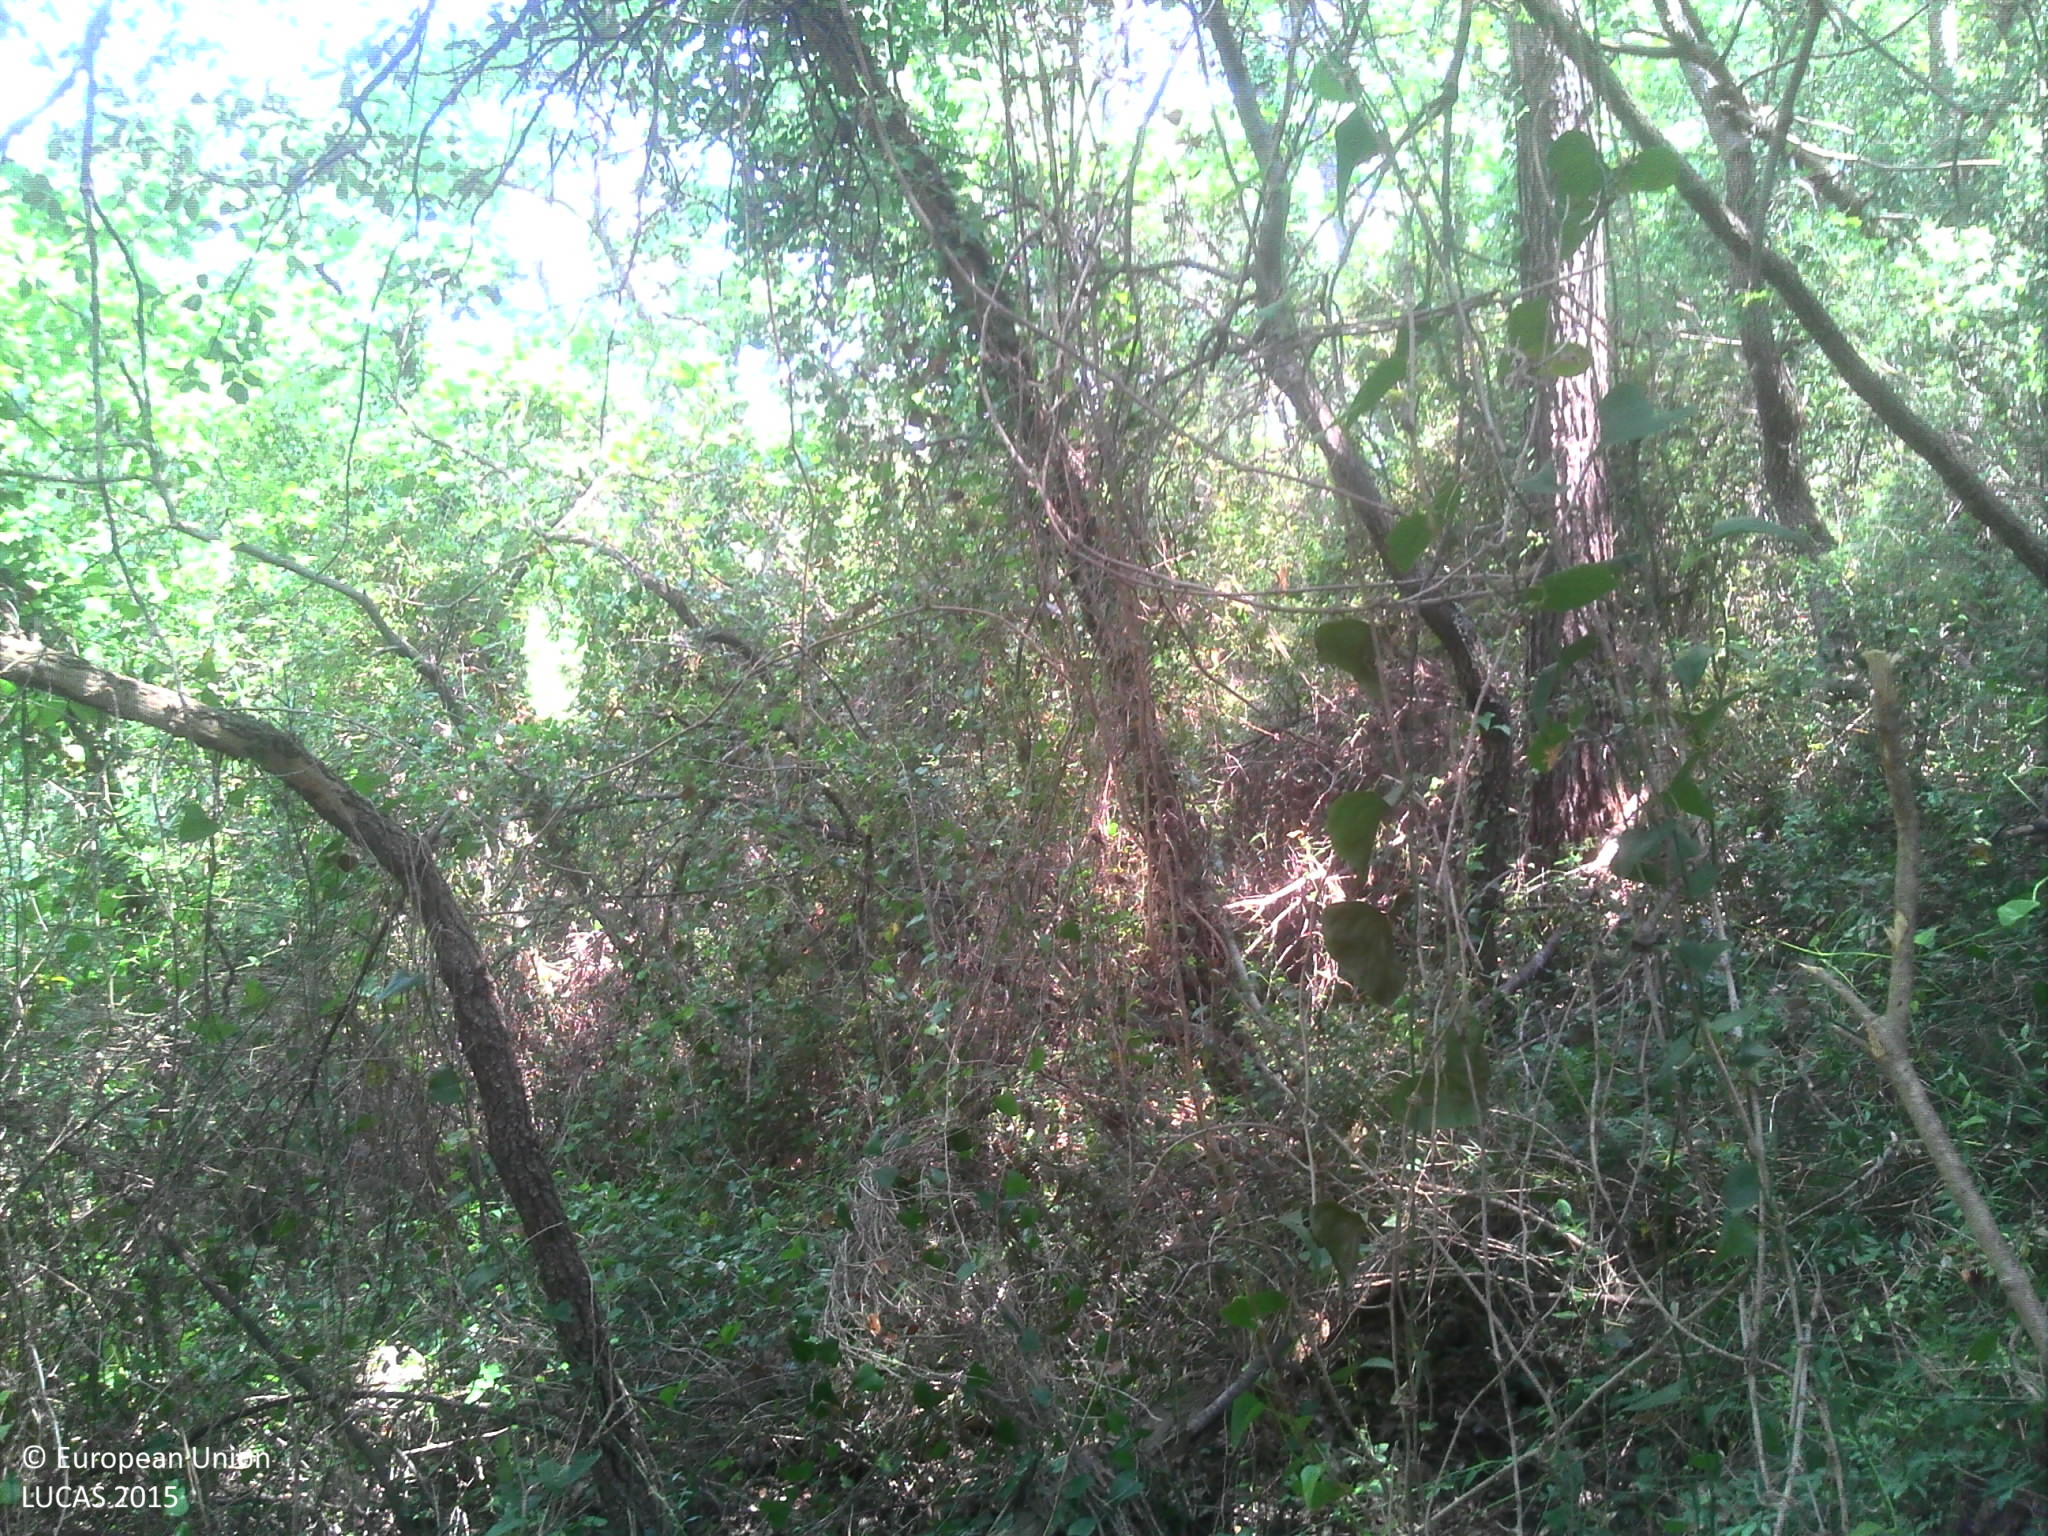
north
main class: Woodland
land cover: Pine dominated mixed woodland
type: broadleaved evergreen forest
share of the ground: > 75 %
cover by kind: coniferous forest trees 50 %, broadleaved forest trees 30 %, unconsolidated bare surface 10 %
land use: Semi-natural and natural areas not in use
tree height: > 5 m
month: July
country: FR
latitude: 43.3994
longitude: 6.2926
